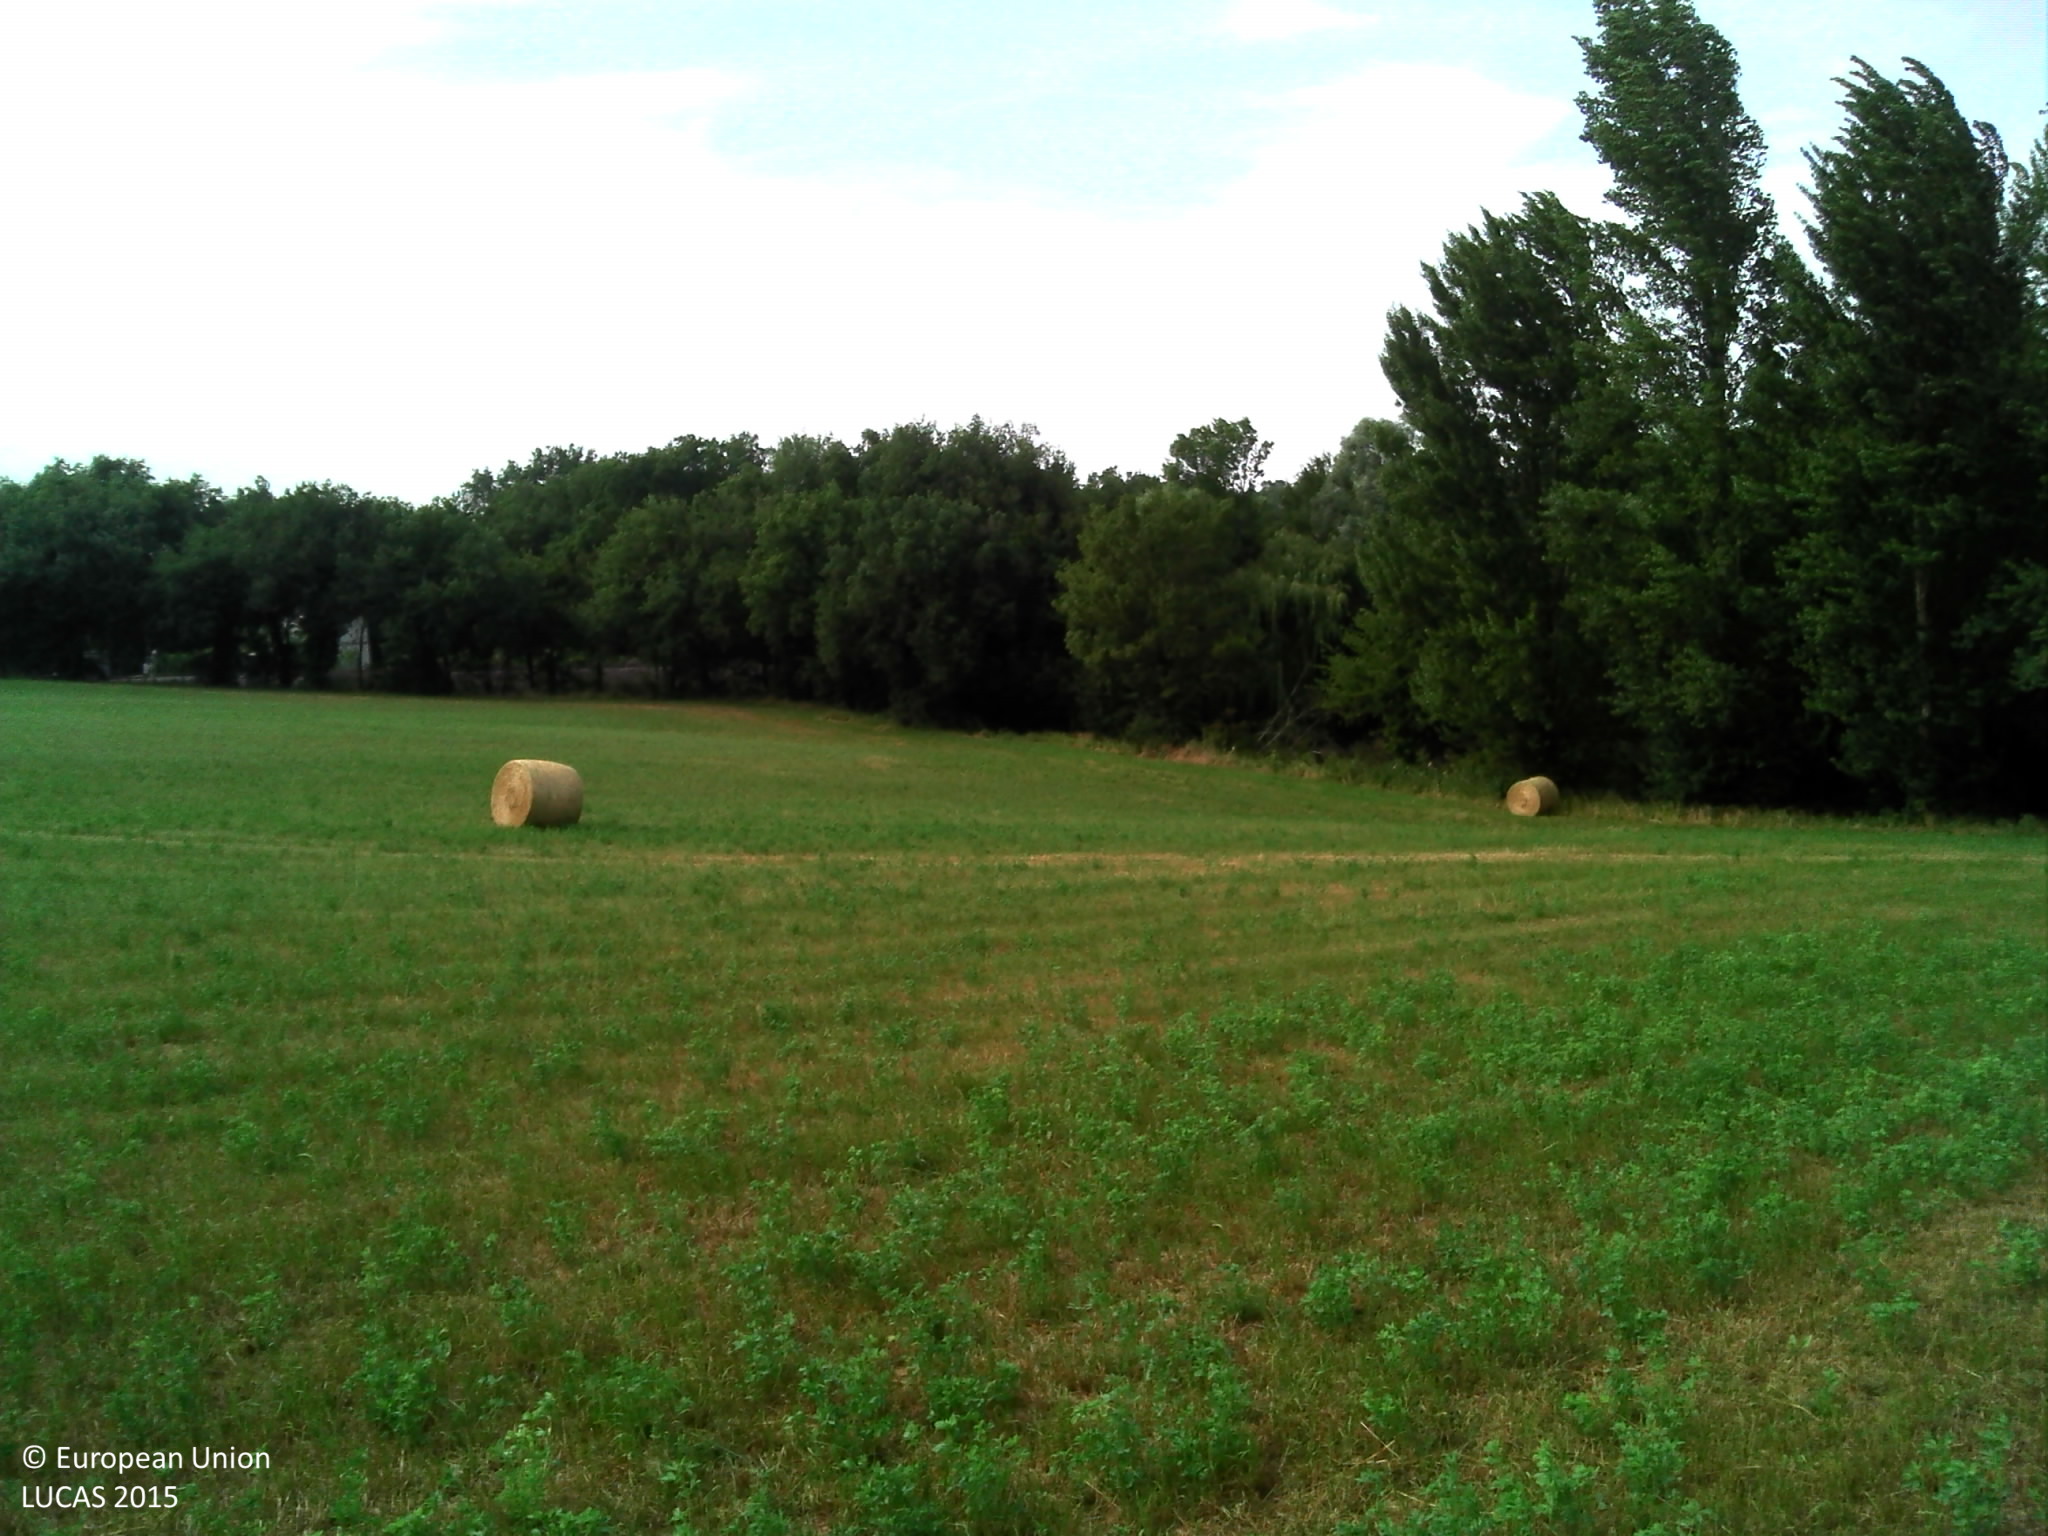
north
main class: Cropland
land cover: Lucerne
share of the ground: > 75 %
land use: Agriculture (excluding fallow land and kitchen gardens)
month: July
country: FR
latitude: 43.6134
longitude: 0.9922
